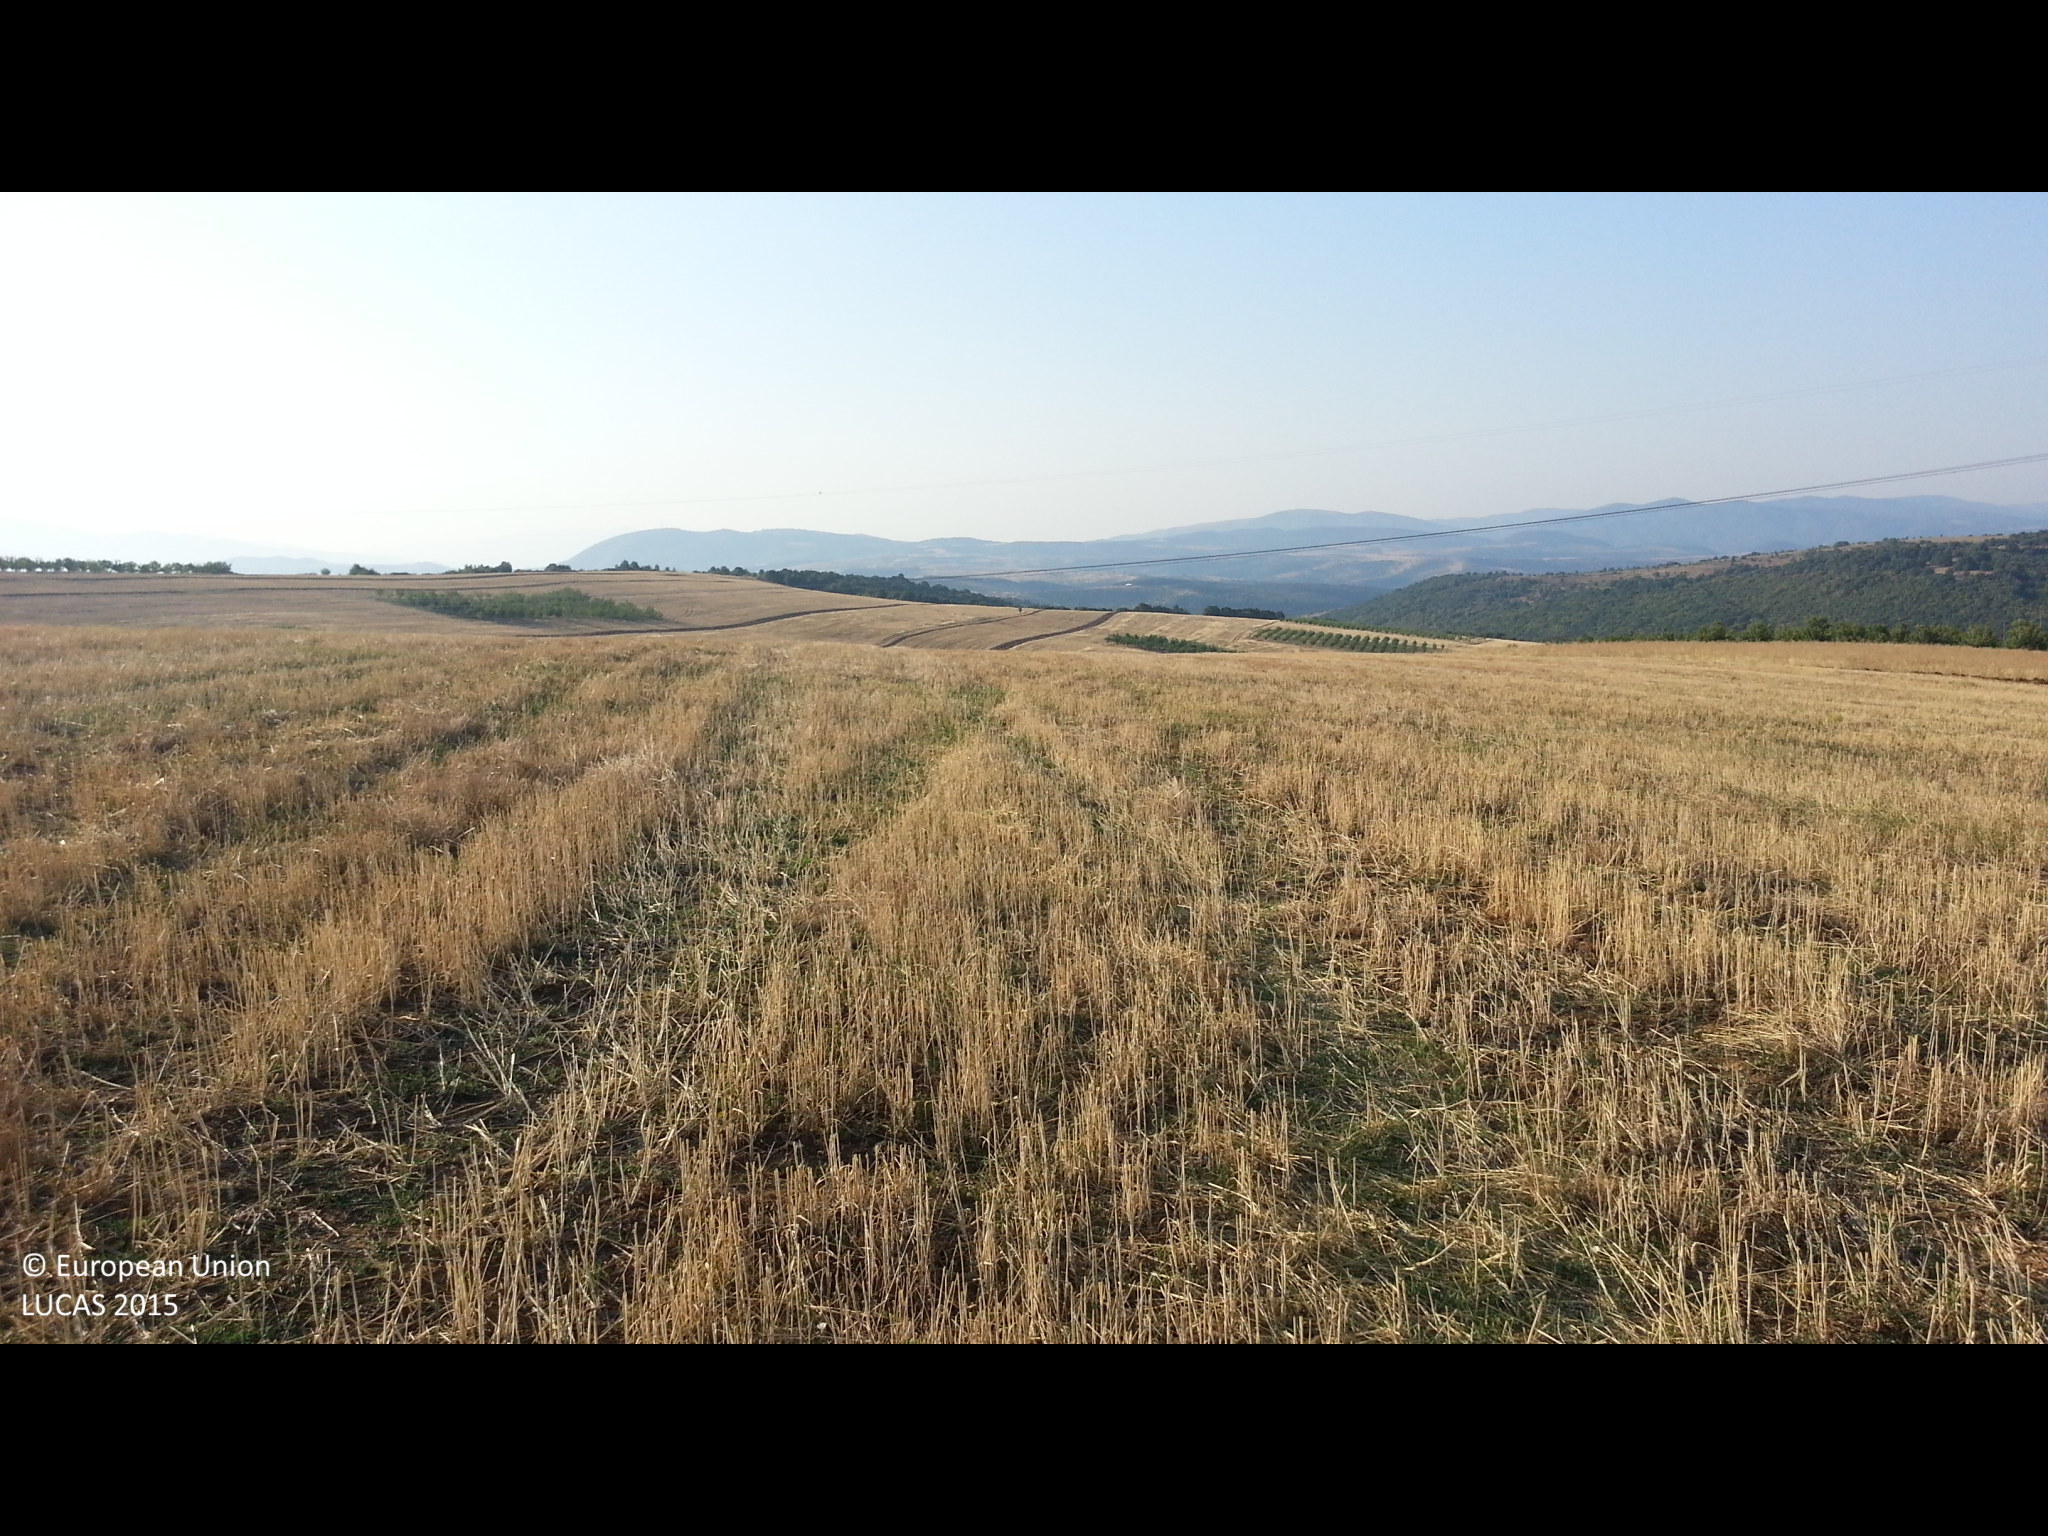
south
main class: Cropland
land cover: Common wheat
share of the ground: 50 - 75 %
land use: Agriculture (excluding fallow land and kitchen gardens)
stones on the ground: < 10 %
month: September
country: BG
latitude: 42.3156
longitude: 22.9223
